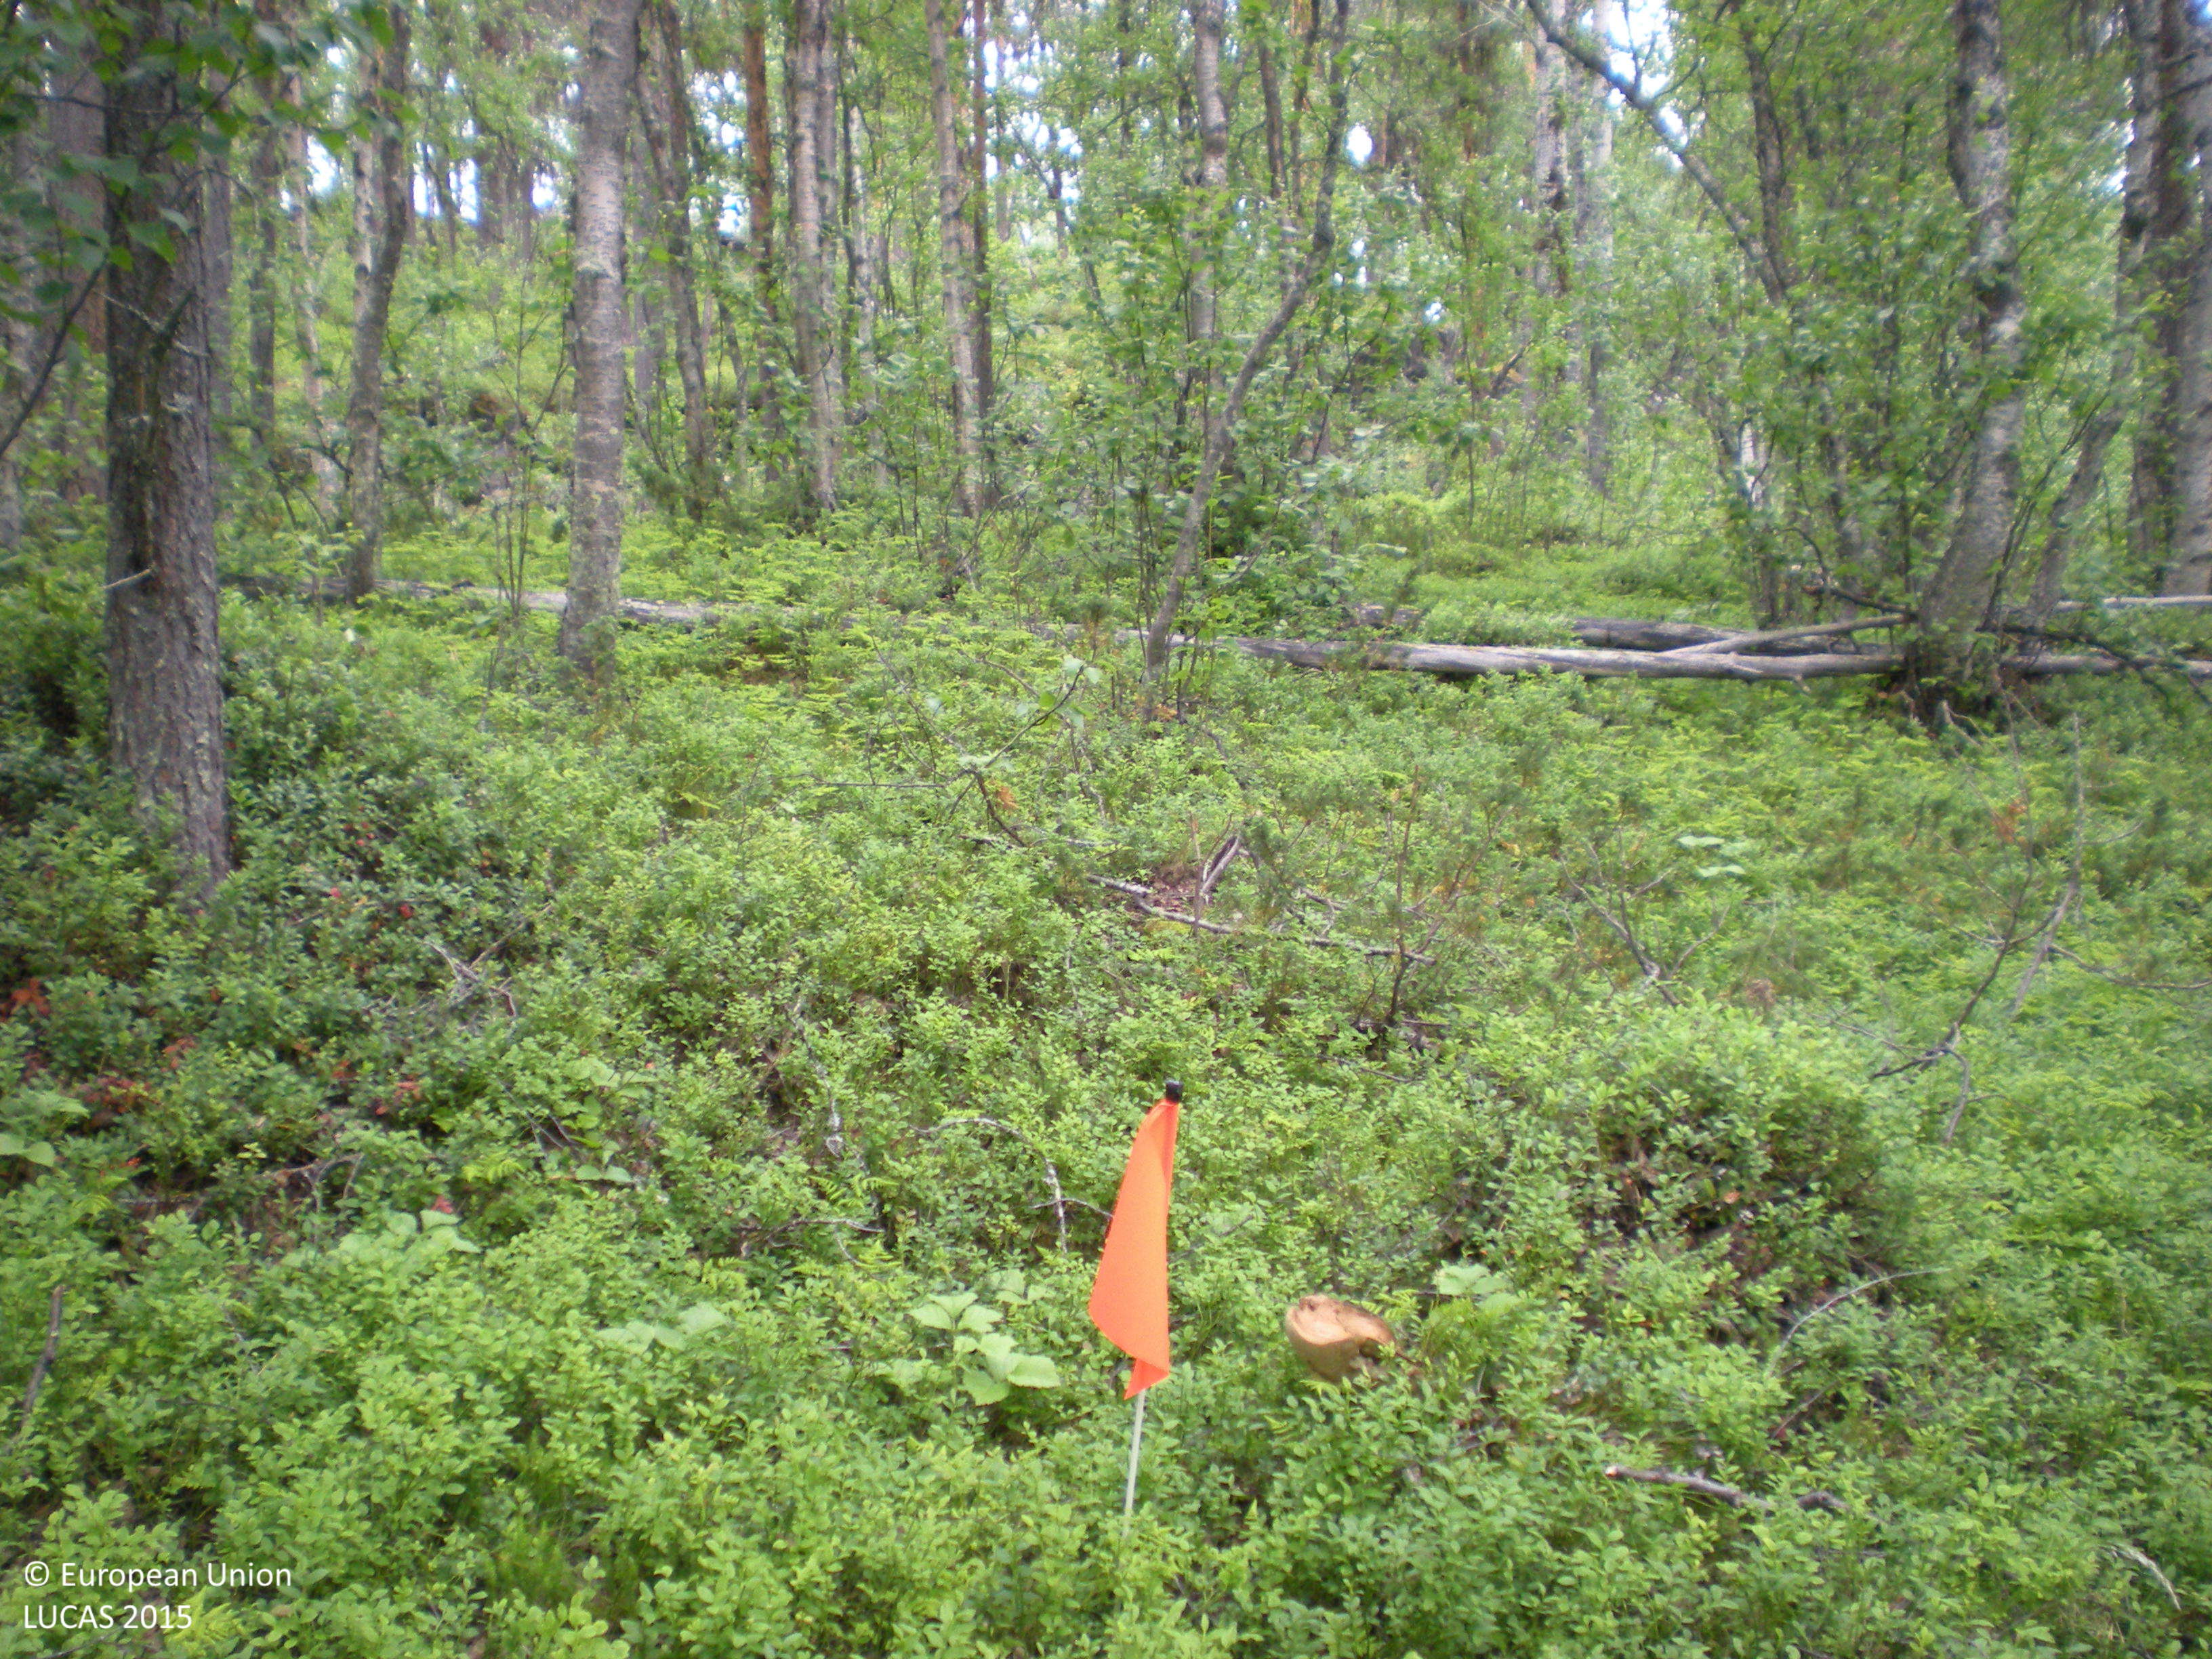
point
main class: Woodland
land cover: Pine dominated mixed woodland
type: boreal forest
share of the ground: 50 - 75 %
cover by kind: coniferous forest trees 35 %, broadleaved forest trees 35 %, shrubs 25 %, herbaceous plants 5 %
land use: Forestry
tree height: > 5 m
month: August
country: SE
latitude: 66.3190
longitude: 17.2945
